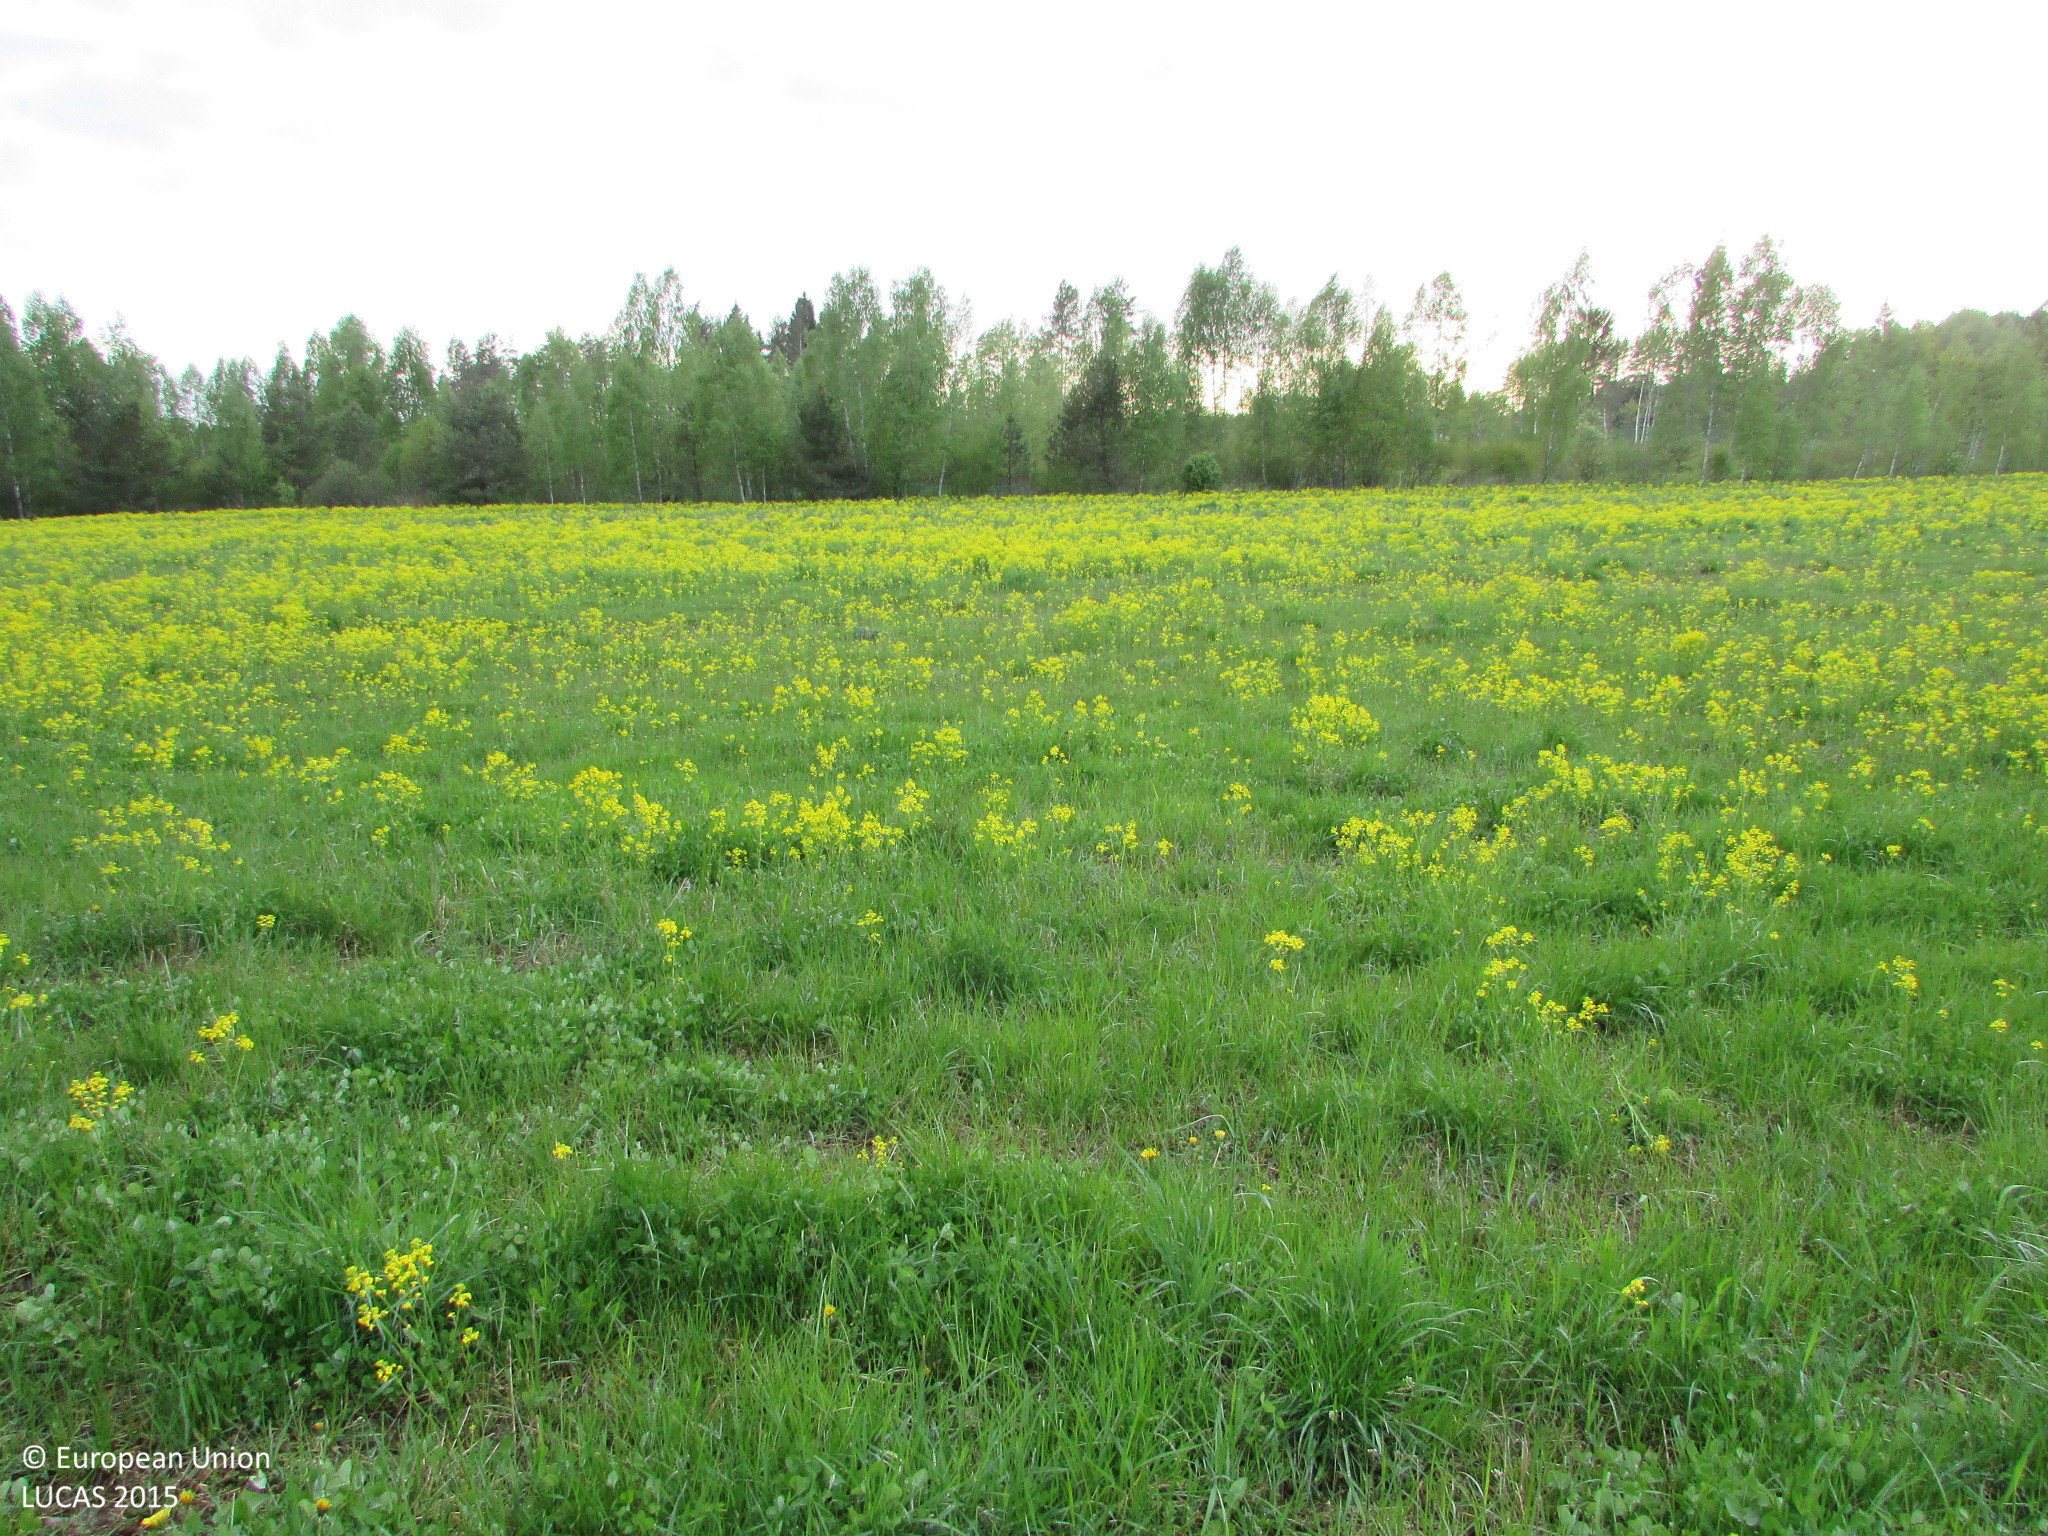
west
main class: Grassland
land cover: Grassland without tree/shrub cover
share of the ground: > 75 %
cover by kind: herbaceous plants 95 %, unconsolidated bare surface 5 %
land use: Agriculture (excluding fallow land and kitchen gardens)
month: May
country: LV
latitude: 56.2270
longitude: 27.2203
